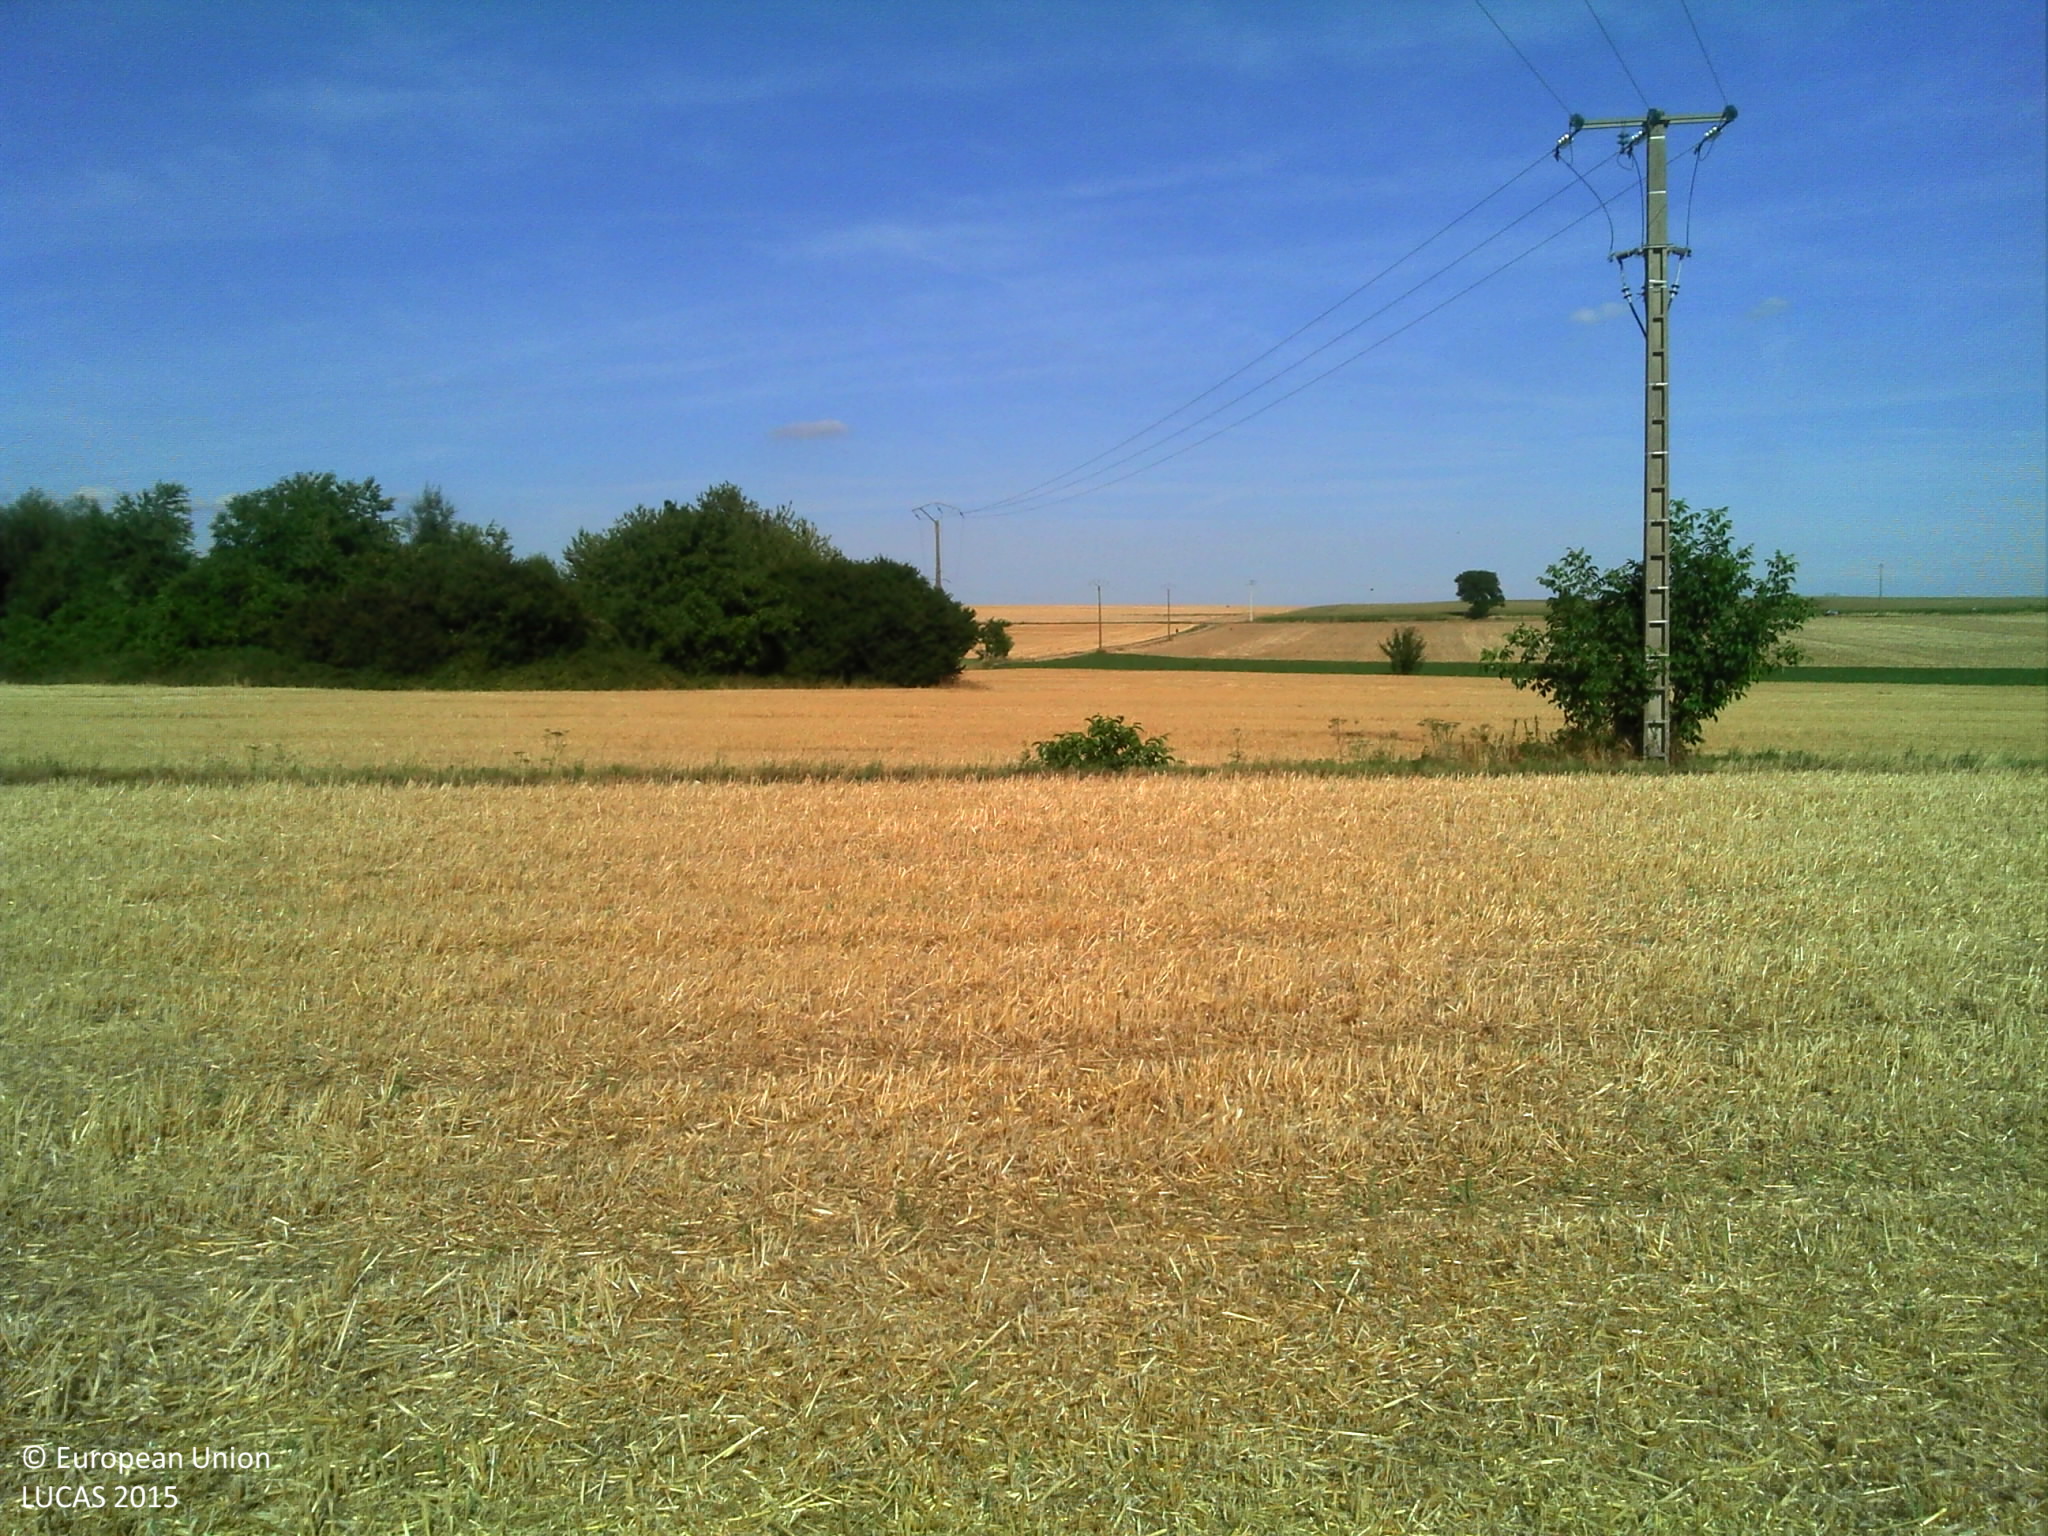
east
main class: Cropland
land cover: Common wheat
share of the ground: > 75 %
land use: Agriculture (excluding fallow land and kitchen gardens)
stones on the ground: < 10 %
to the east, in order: Common wheat; Grass margins; Paved roads, cycling and walking lanes; Grass margins; Common wheat; Ditches and canals; Sugar beet
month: August
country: FR
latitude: 49.0620
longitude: 1.8689
